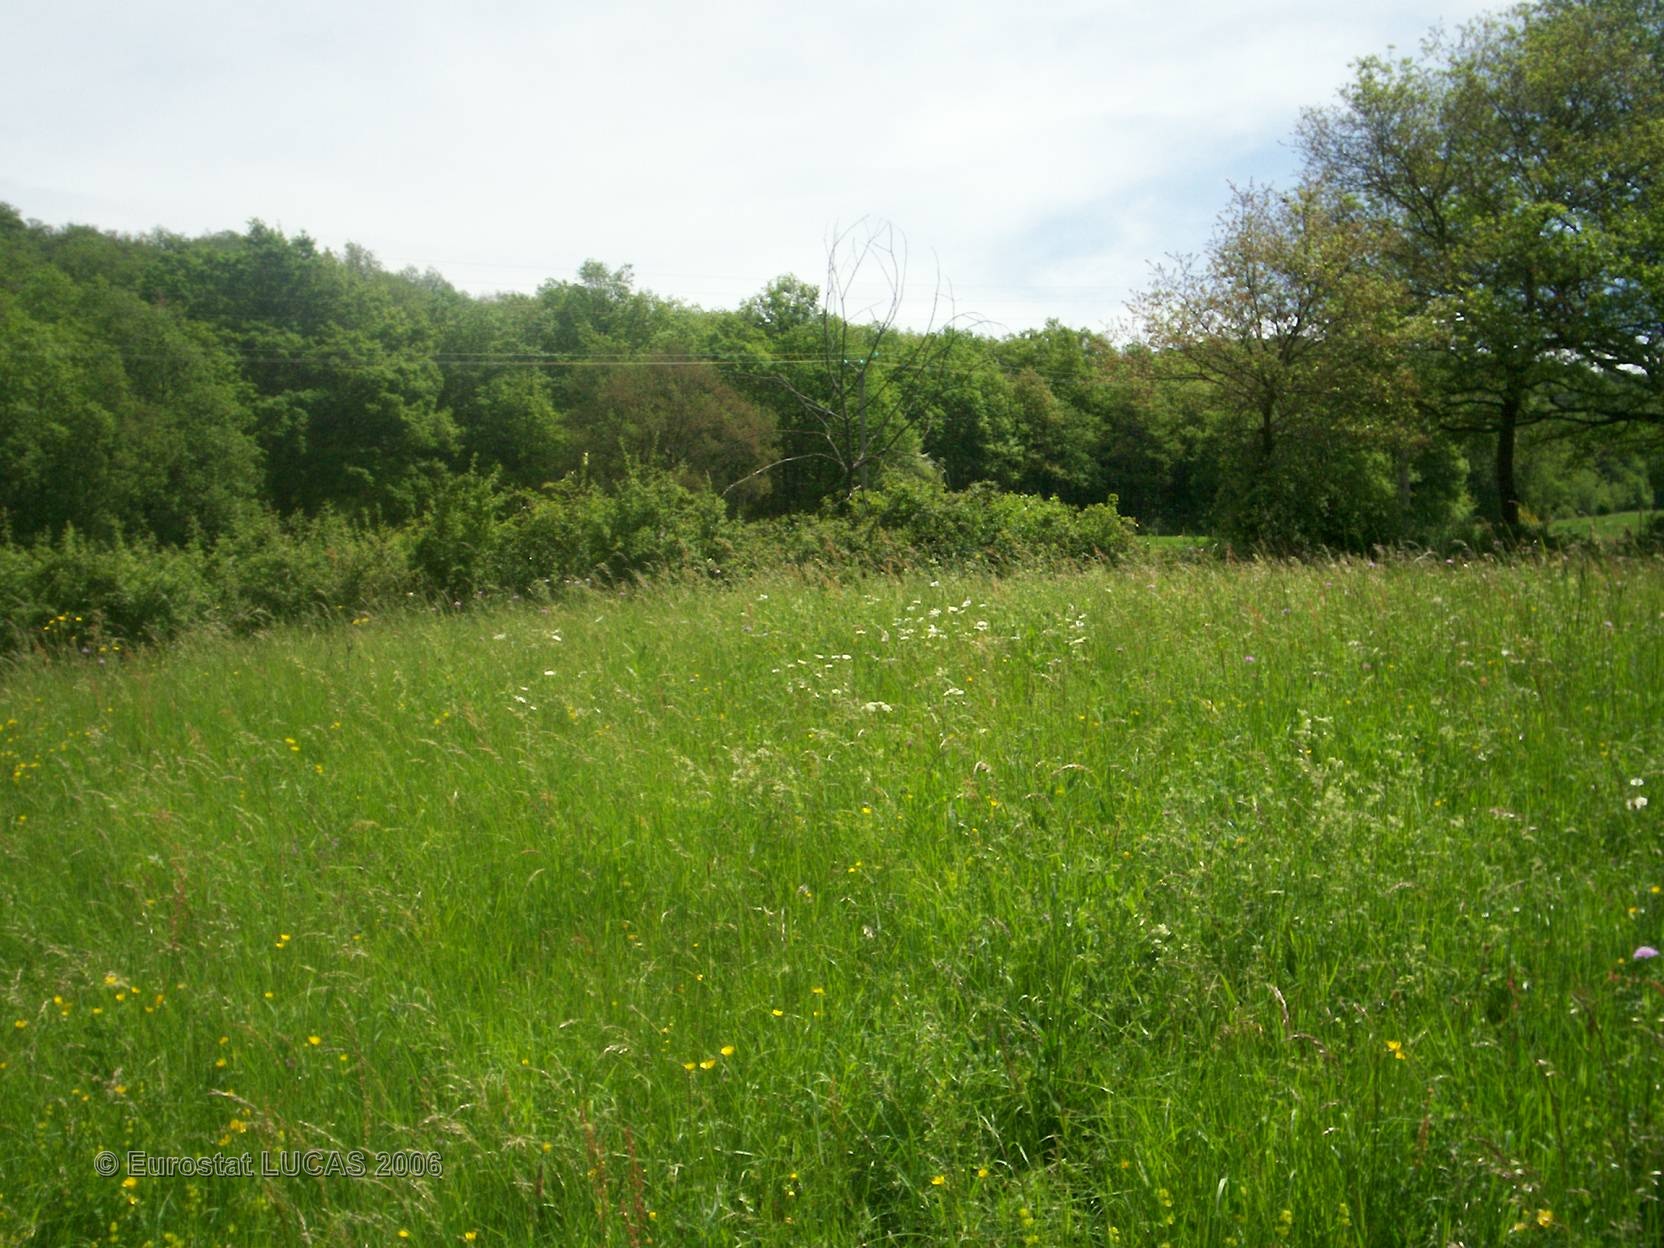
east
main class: Grassland
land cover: Grassland without tree/shrub cover
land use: Agriculture (excluding fallow land and kitchen gardens)
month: May
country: FR
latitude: 45.4371
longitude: 3.3158
